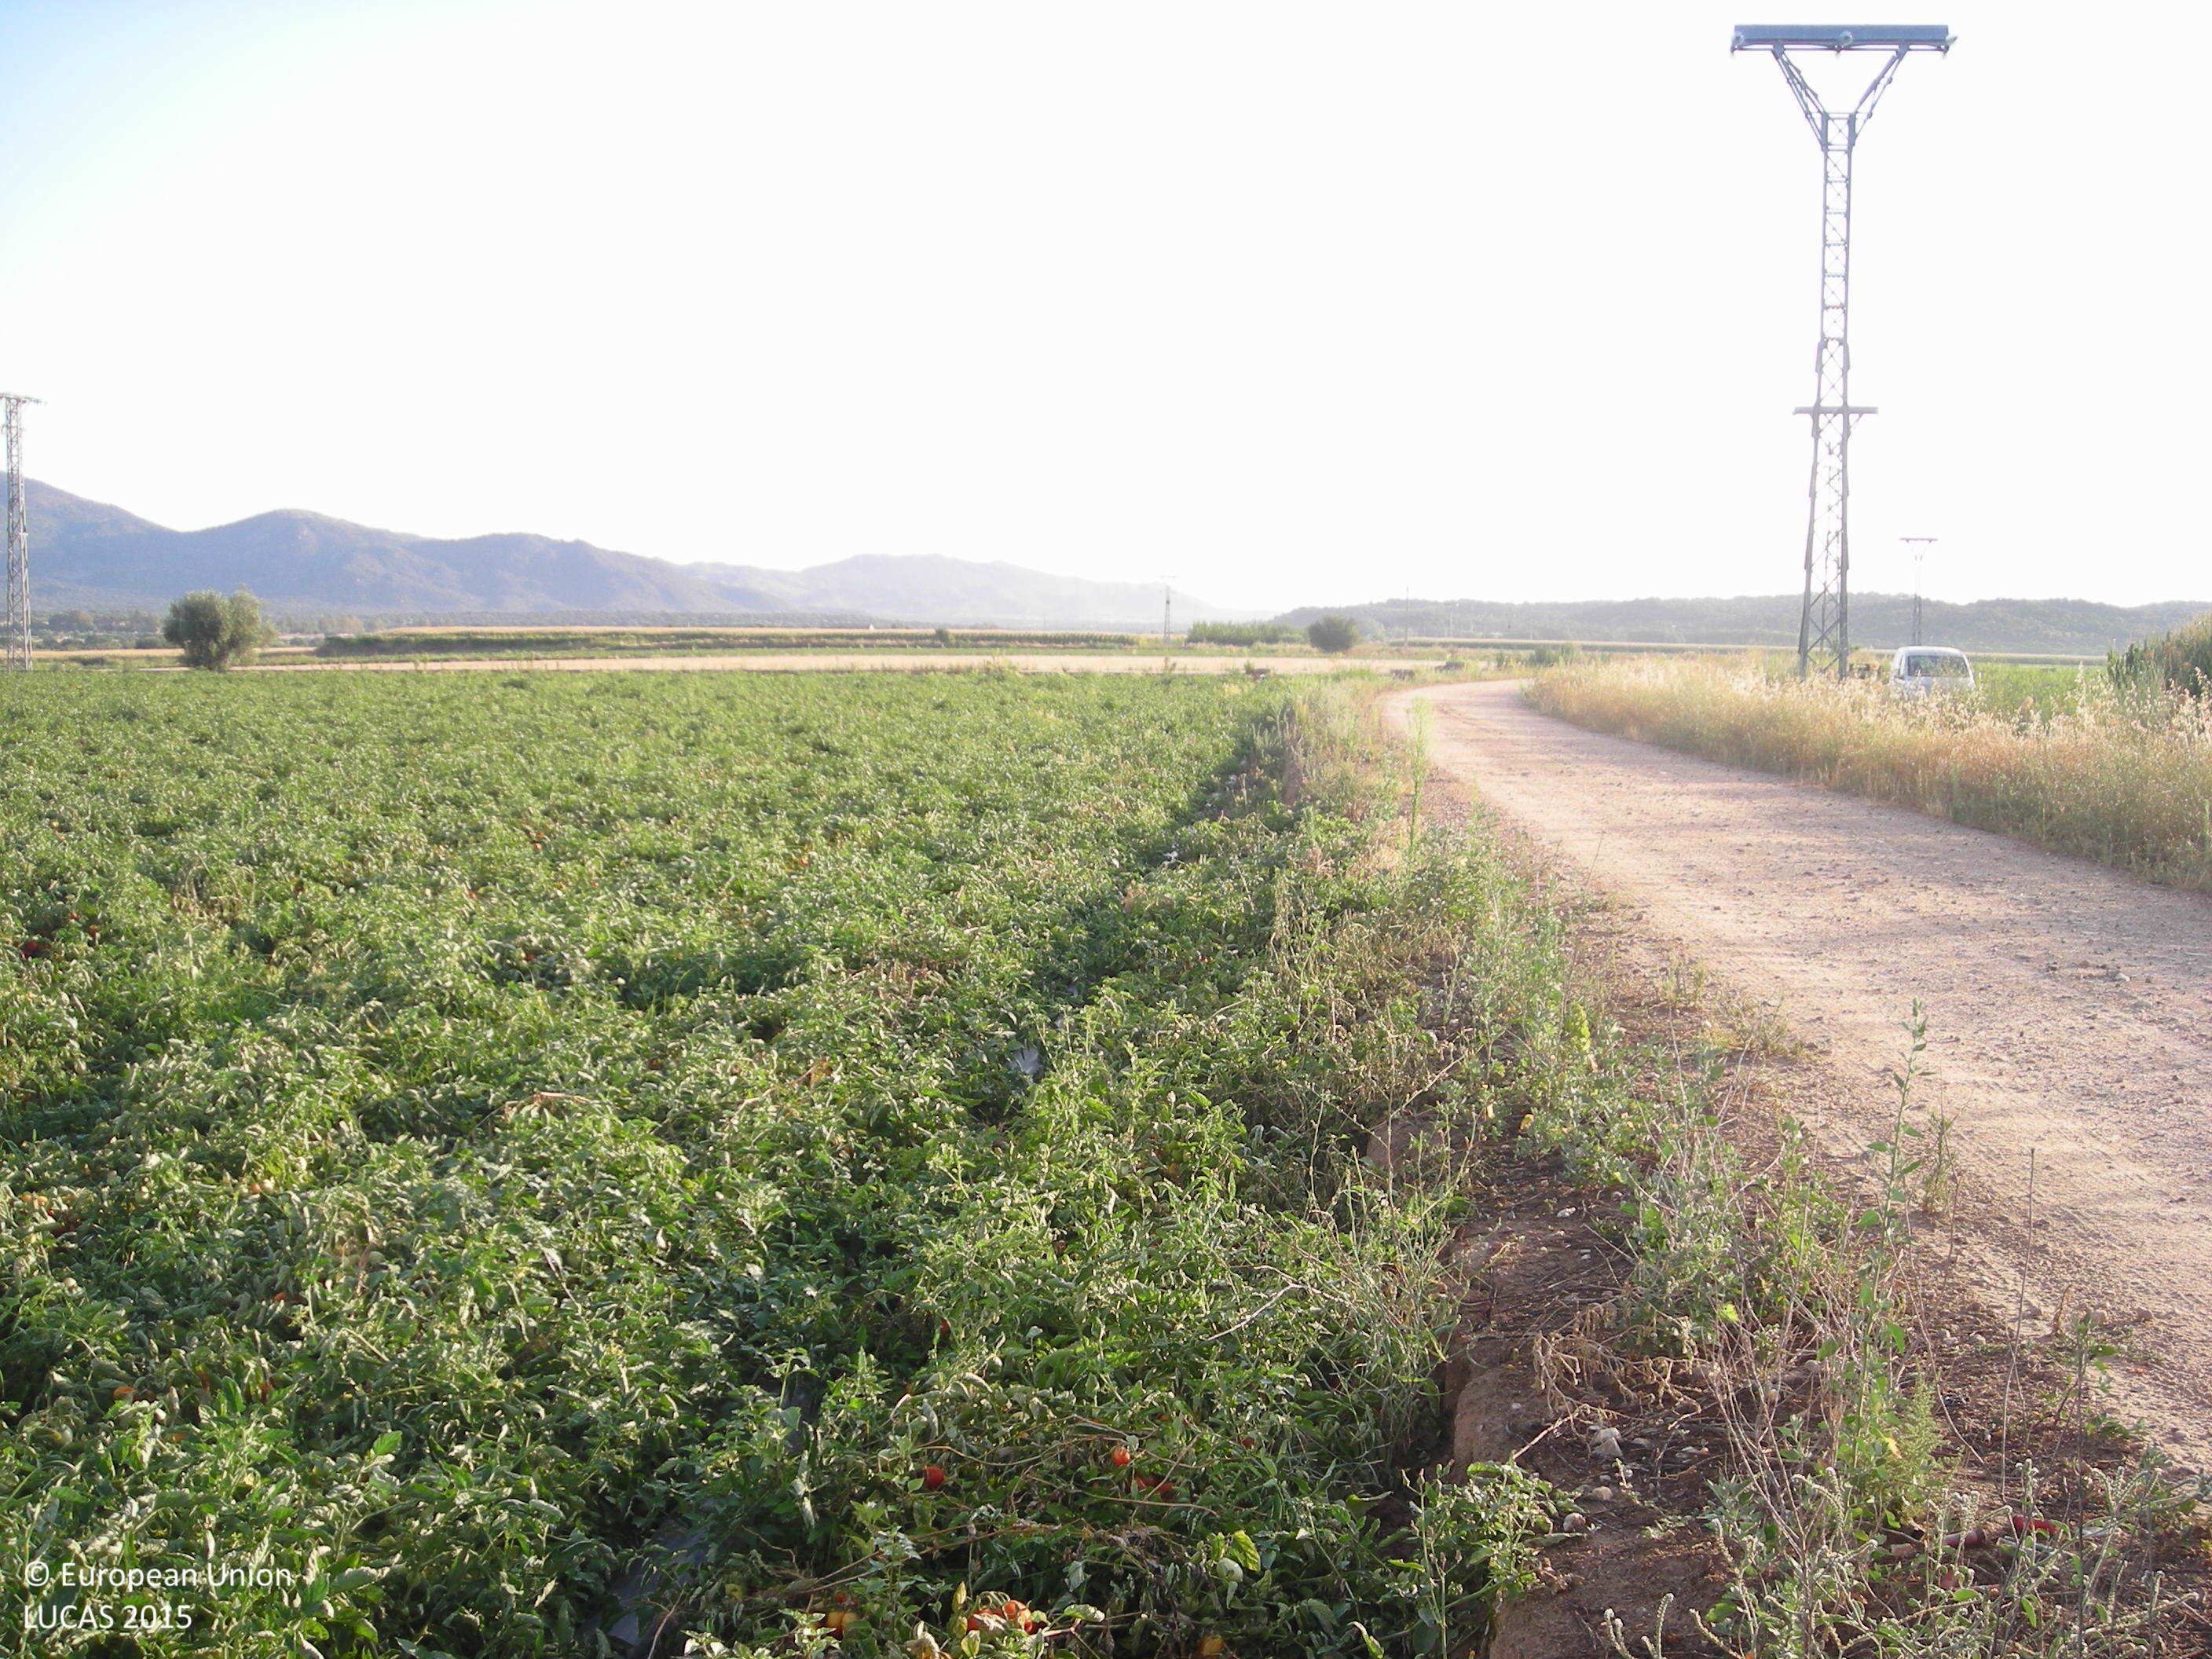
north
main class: Cropland
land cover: Tomatoes
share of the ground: > 75 %
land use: Agriculture (excluding fallow land and kitchen gardens)
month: July
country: ES
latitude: 39.1276
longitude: -6.0065
